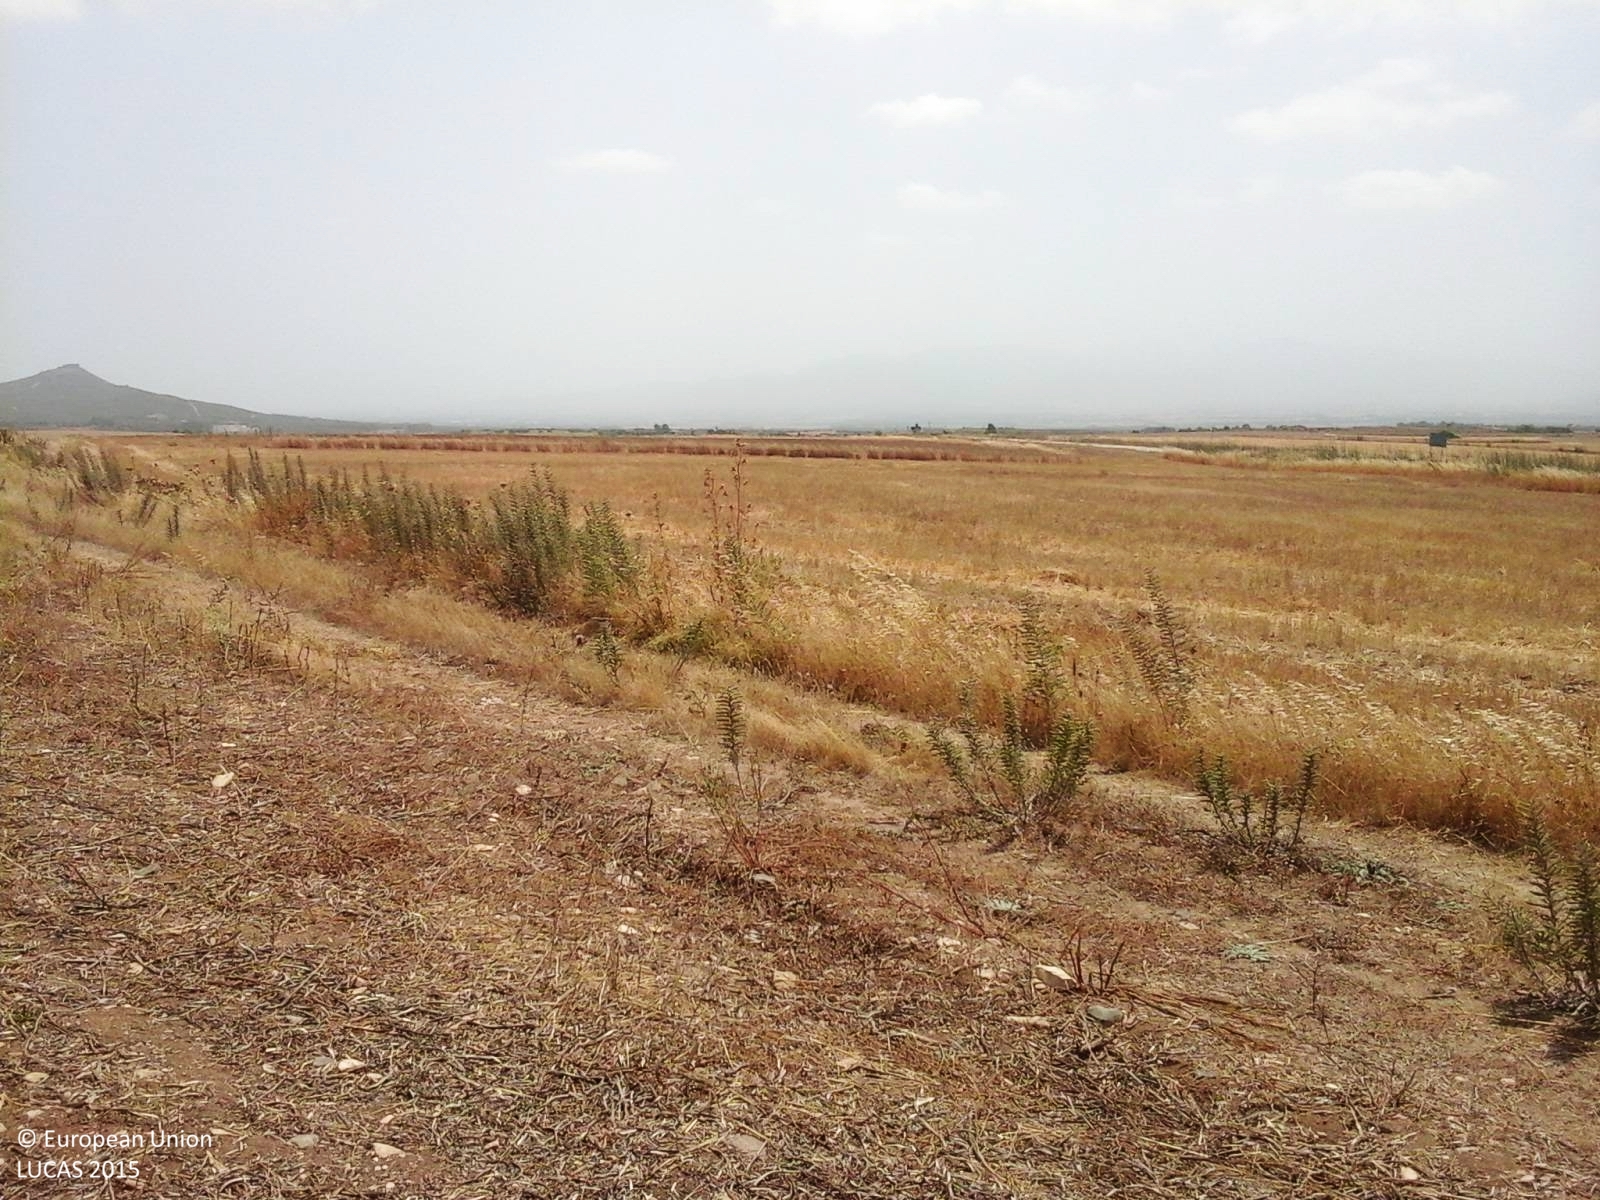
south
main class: Cropland
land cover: Oats
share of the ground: 10 - 25 %
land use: Agriculture (excluding fallow land and kitchen gardens)
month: July
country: IT
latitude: 39.6441
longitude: 8.7835
